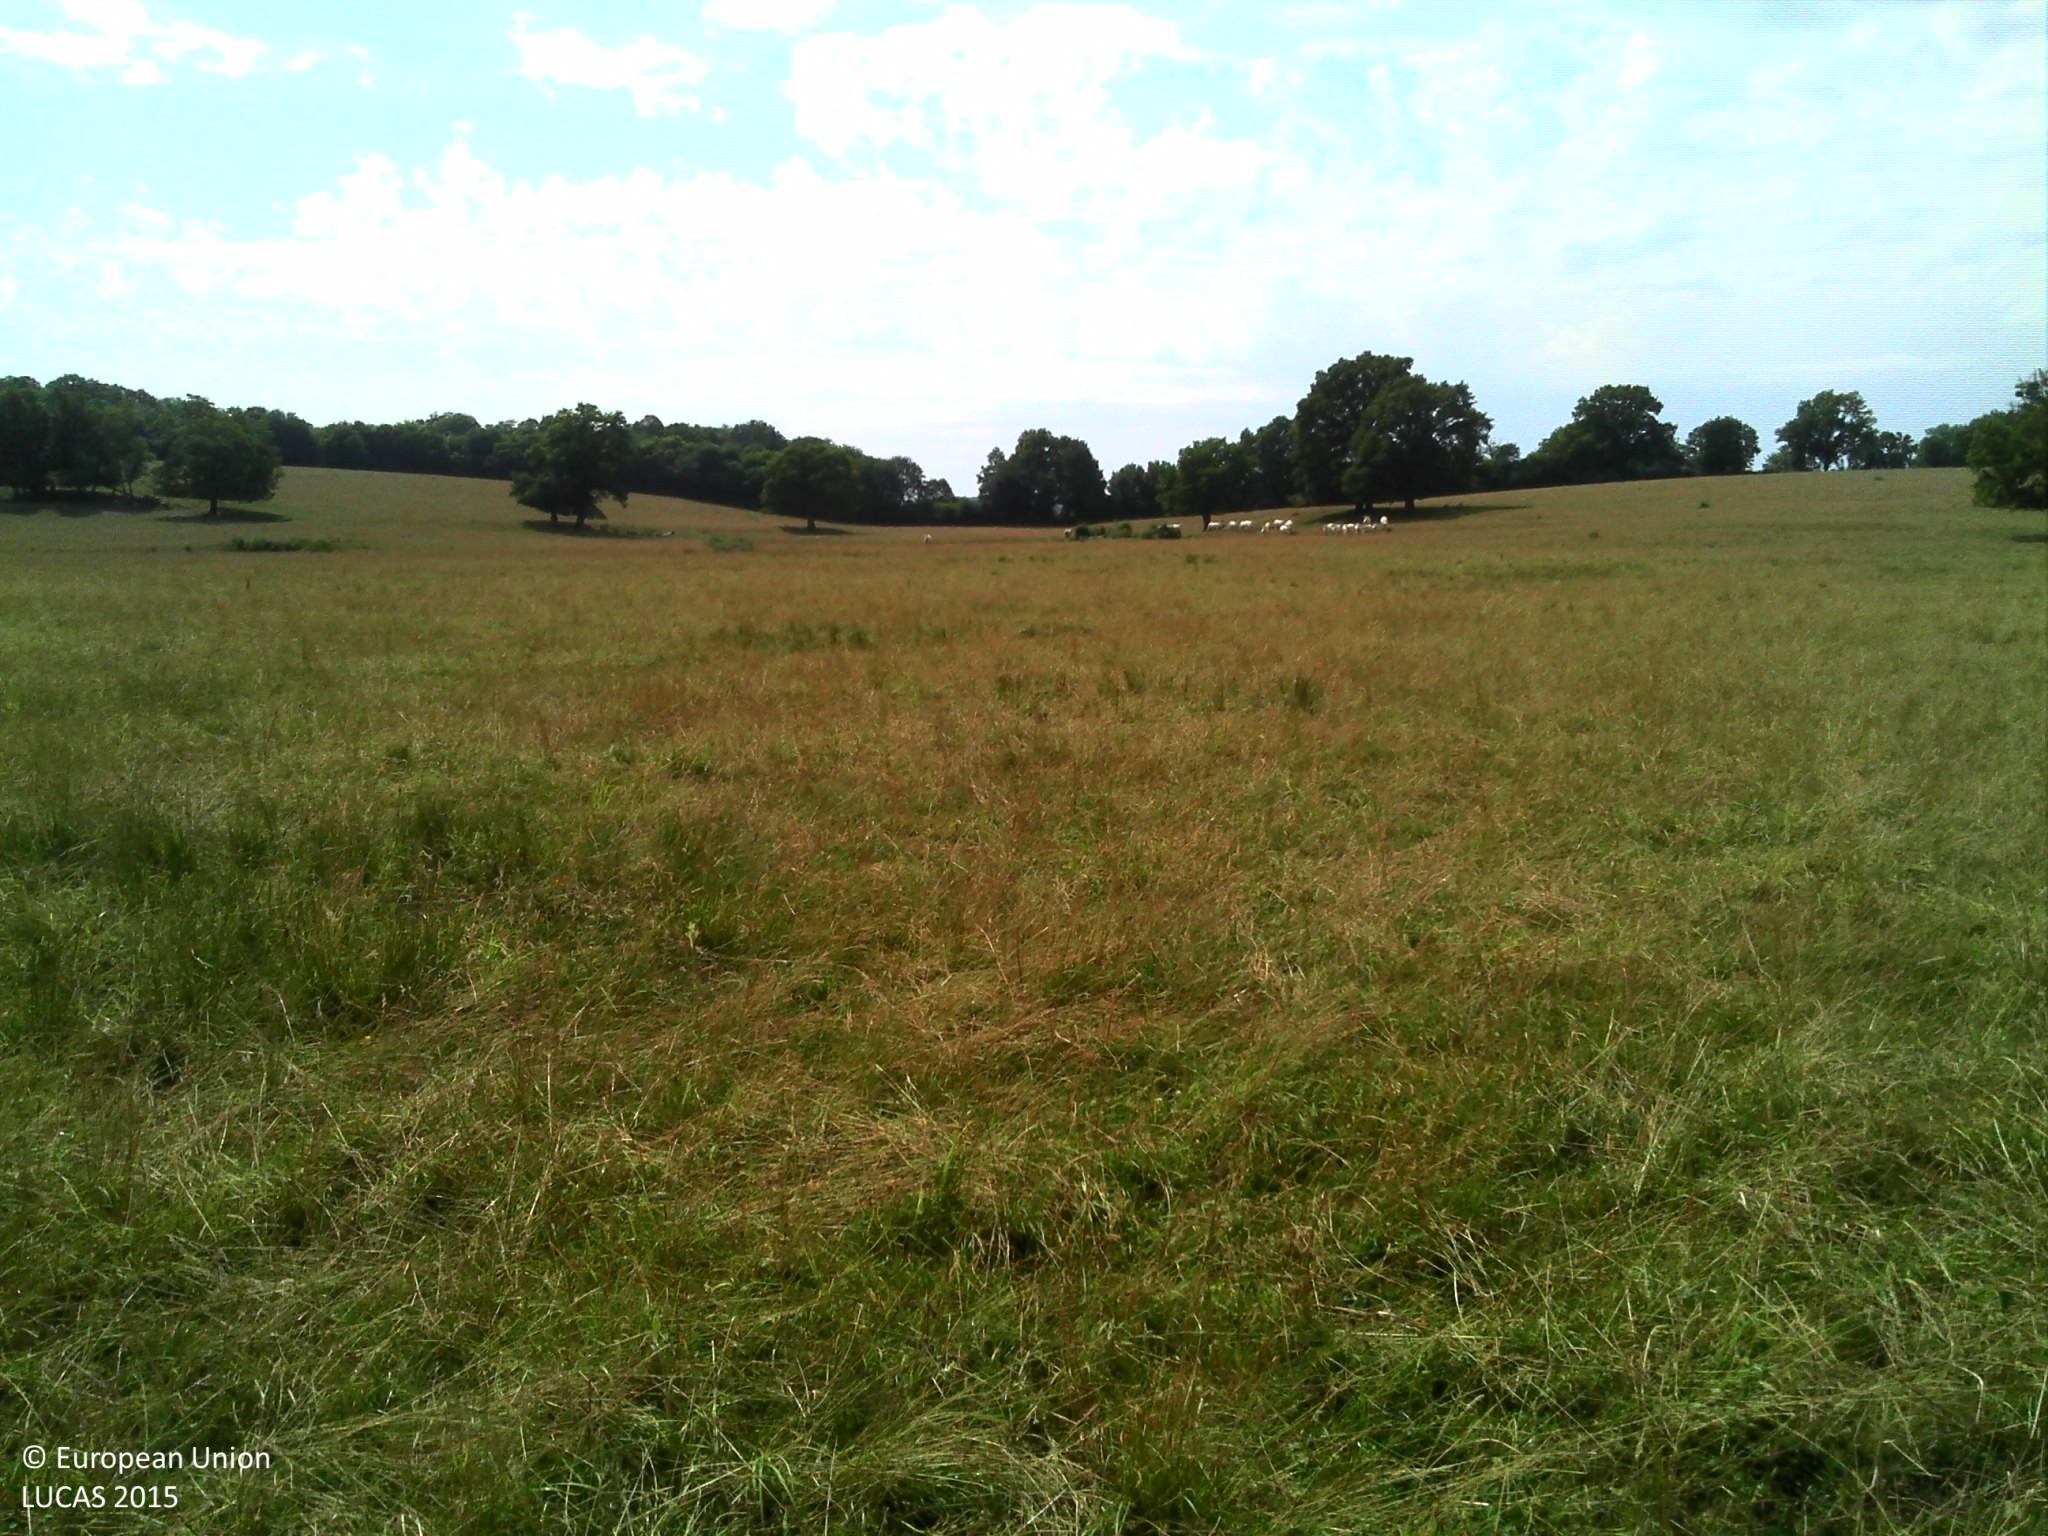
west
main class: Grassland
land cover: Grassland without tree/shrub cover
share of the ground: > 75 %
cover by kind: herbaceous plants 100 %
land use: Agriculture (excluding fallow land and kitchen gardens)
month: July
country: FR
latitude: 47.2215
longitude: 3.5394
